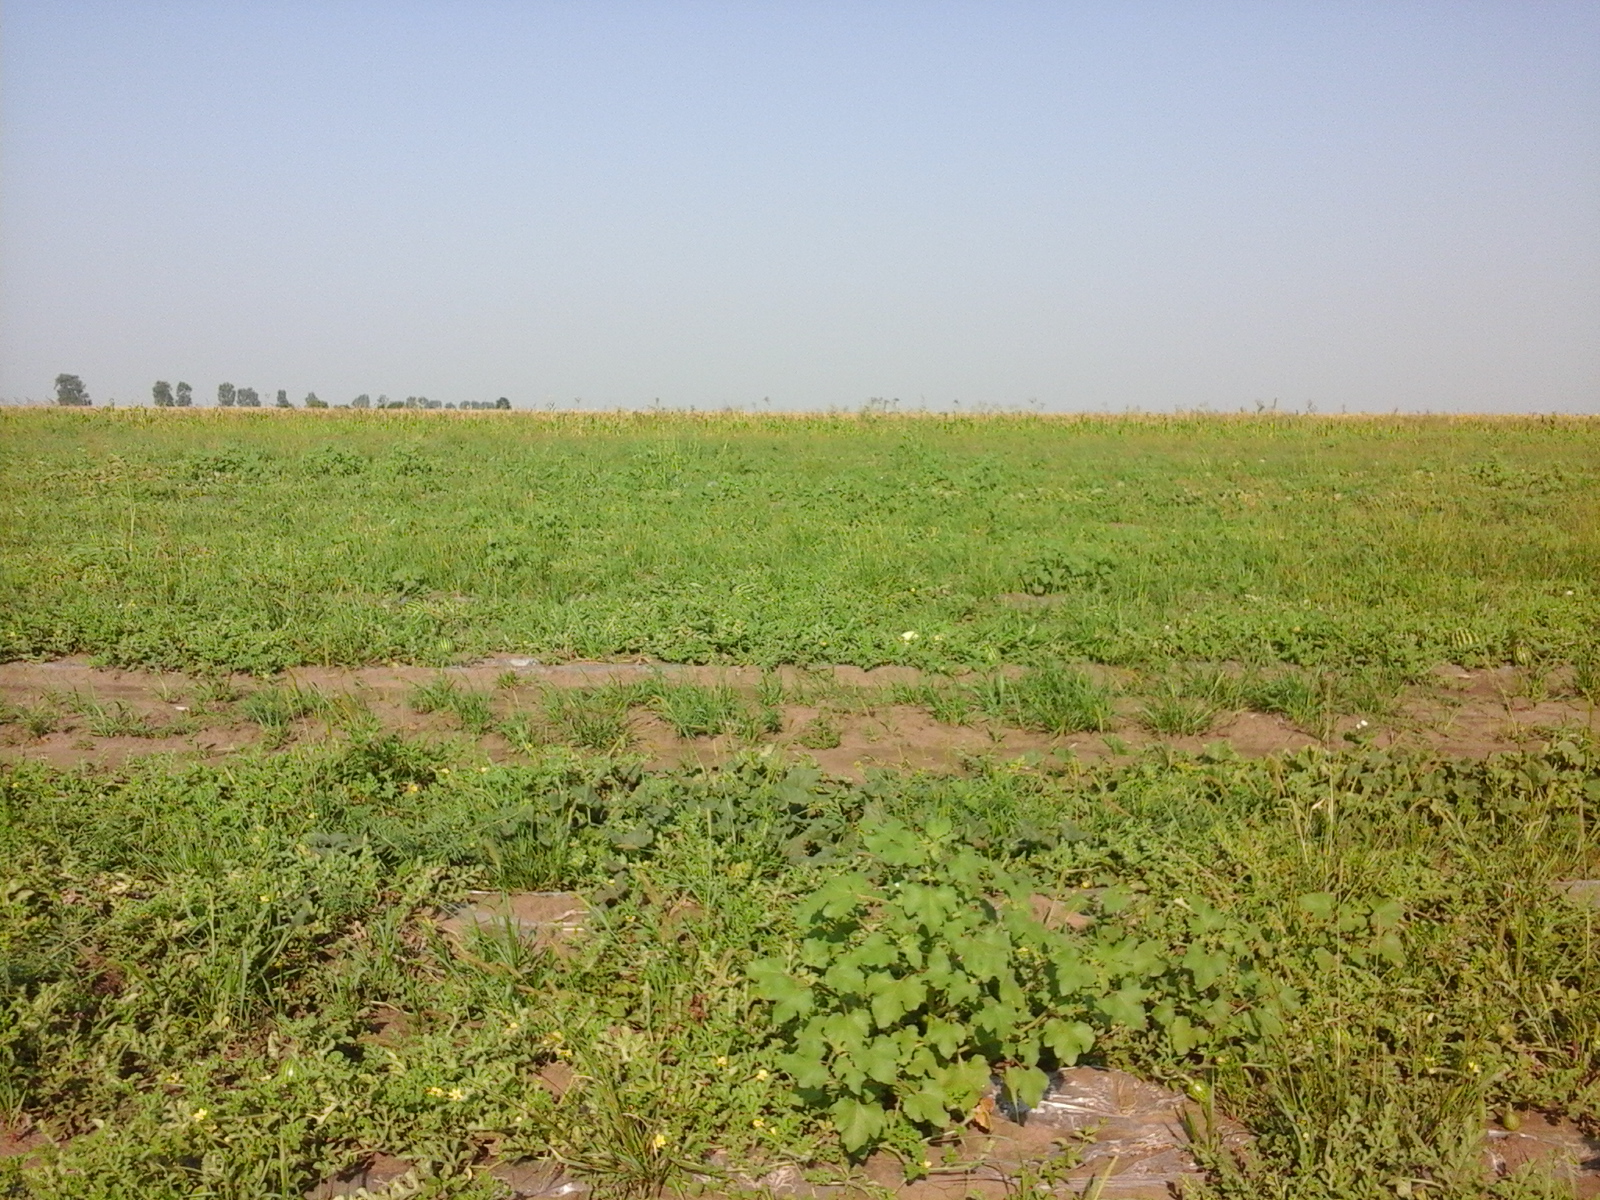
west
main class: Cropland
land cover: Other fresh vegetables
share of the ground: > 75 %
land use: Agriculture (excluding fallow land and kitchen gardens)
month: August
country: RO
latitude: 45.8382
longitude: 27.5790
